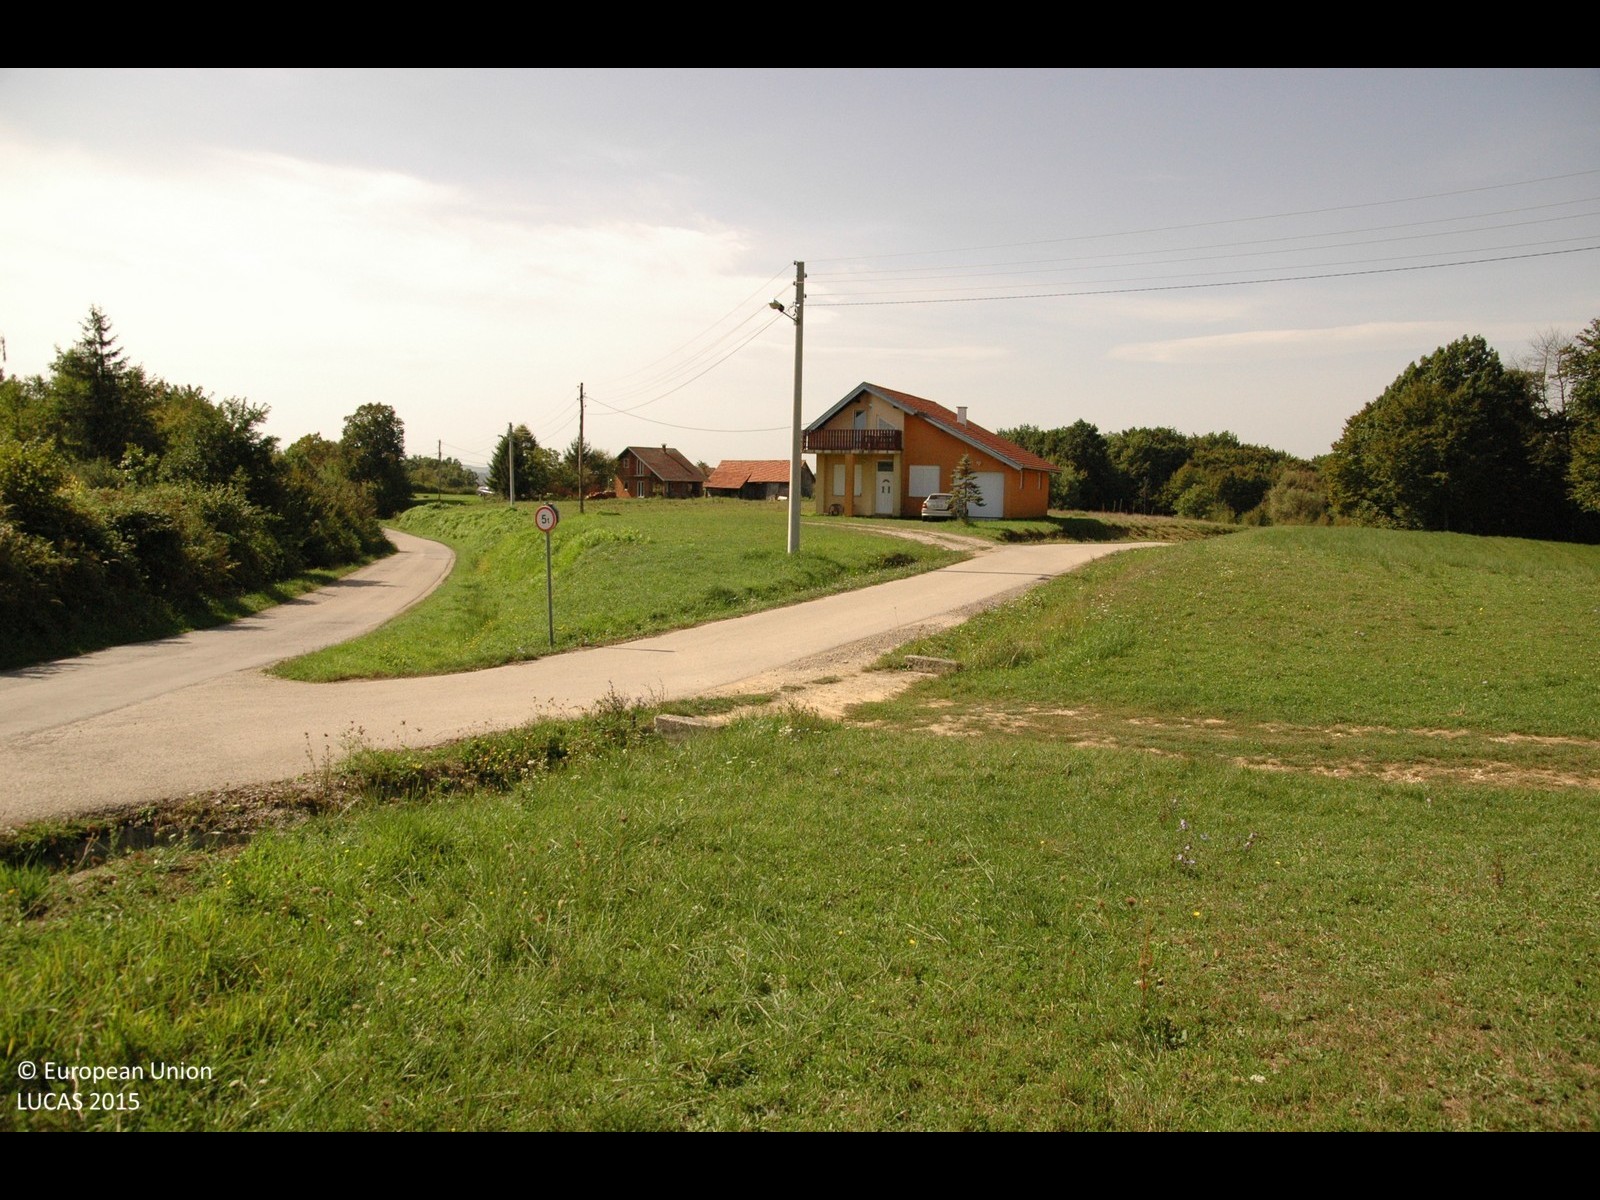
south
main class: Grassland
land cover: Grassland without tree/shrub cover
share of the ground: > 75 %
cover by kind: herbaceous plants 100 %
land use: Agriculture (excluding fallow land and kitchen gardens)
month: September
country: HR
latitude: 45.5560
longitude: 15.9026
